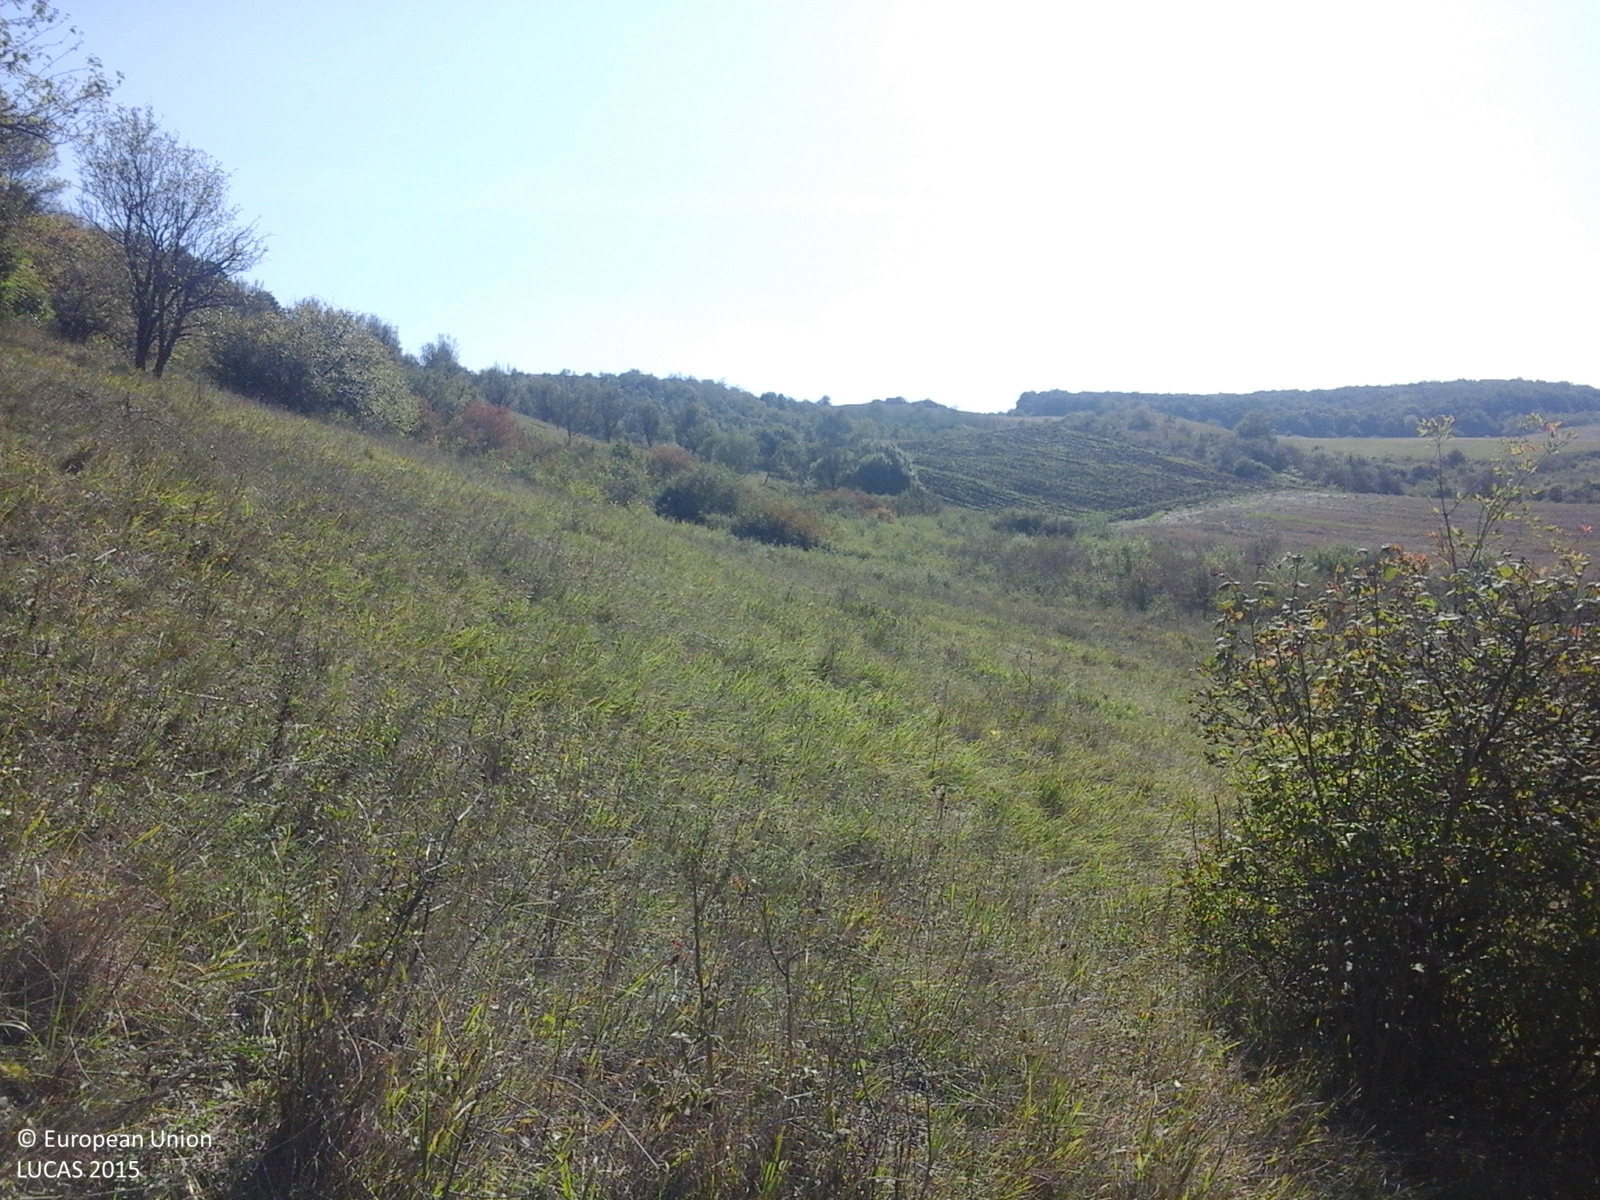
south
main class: Grassland
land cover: Grassland with sparse tree/shrub cover
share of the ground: > 75 %
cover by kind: herbaceous plants 85 %, shrubs 10 %, broadleaved forest trees 5 %
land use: Fallow land
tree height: < 5 m
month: October
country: RO
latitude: 46.2715
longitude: 23.8135
